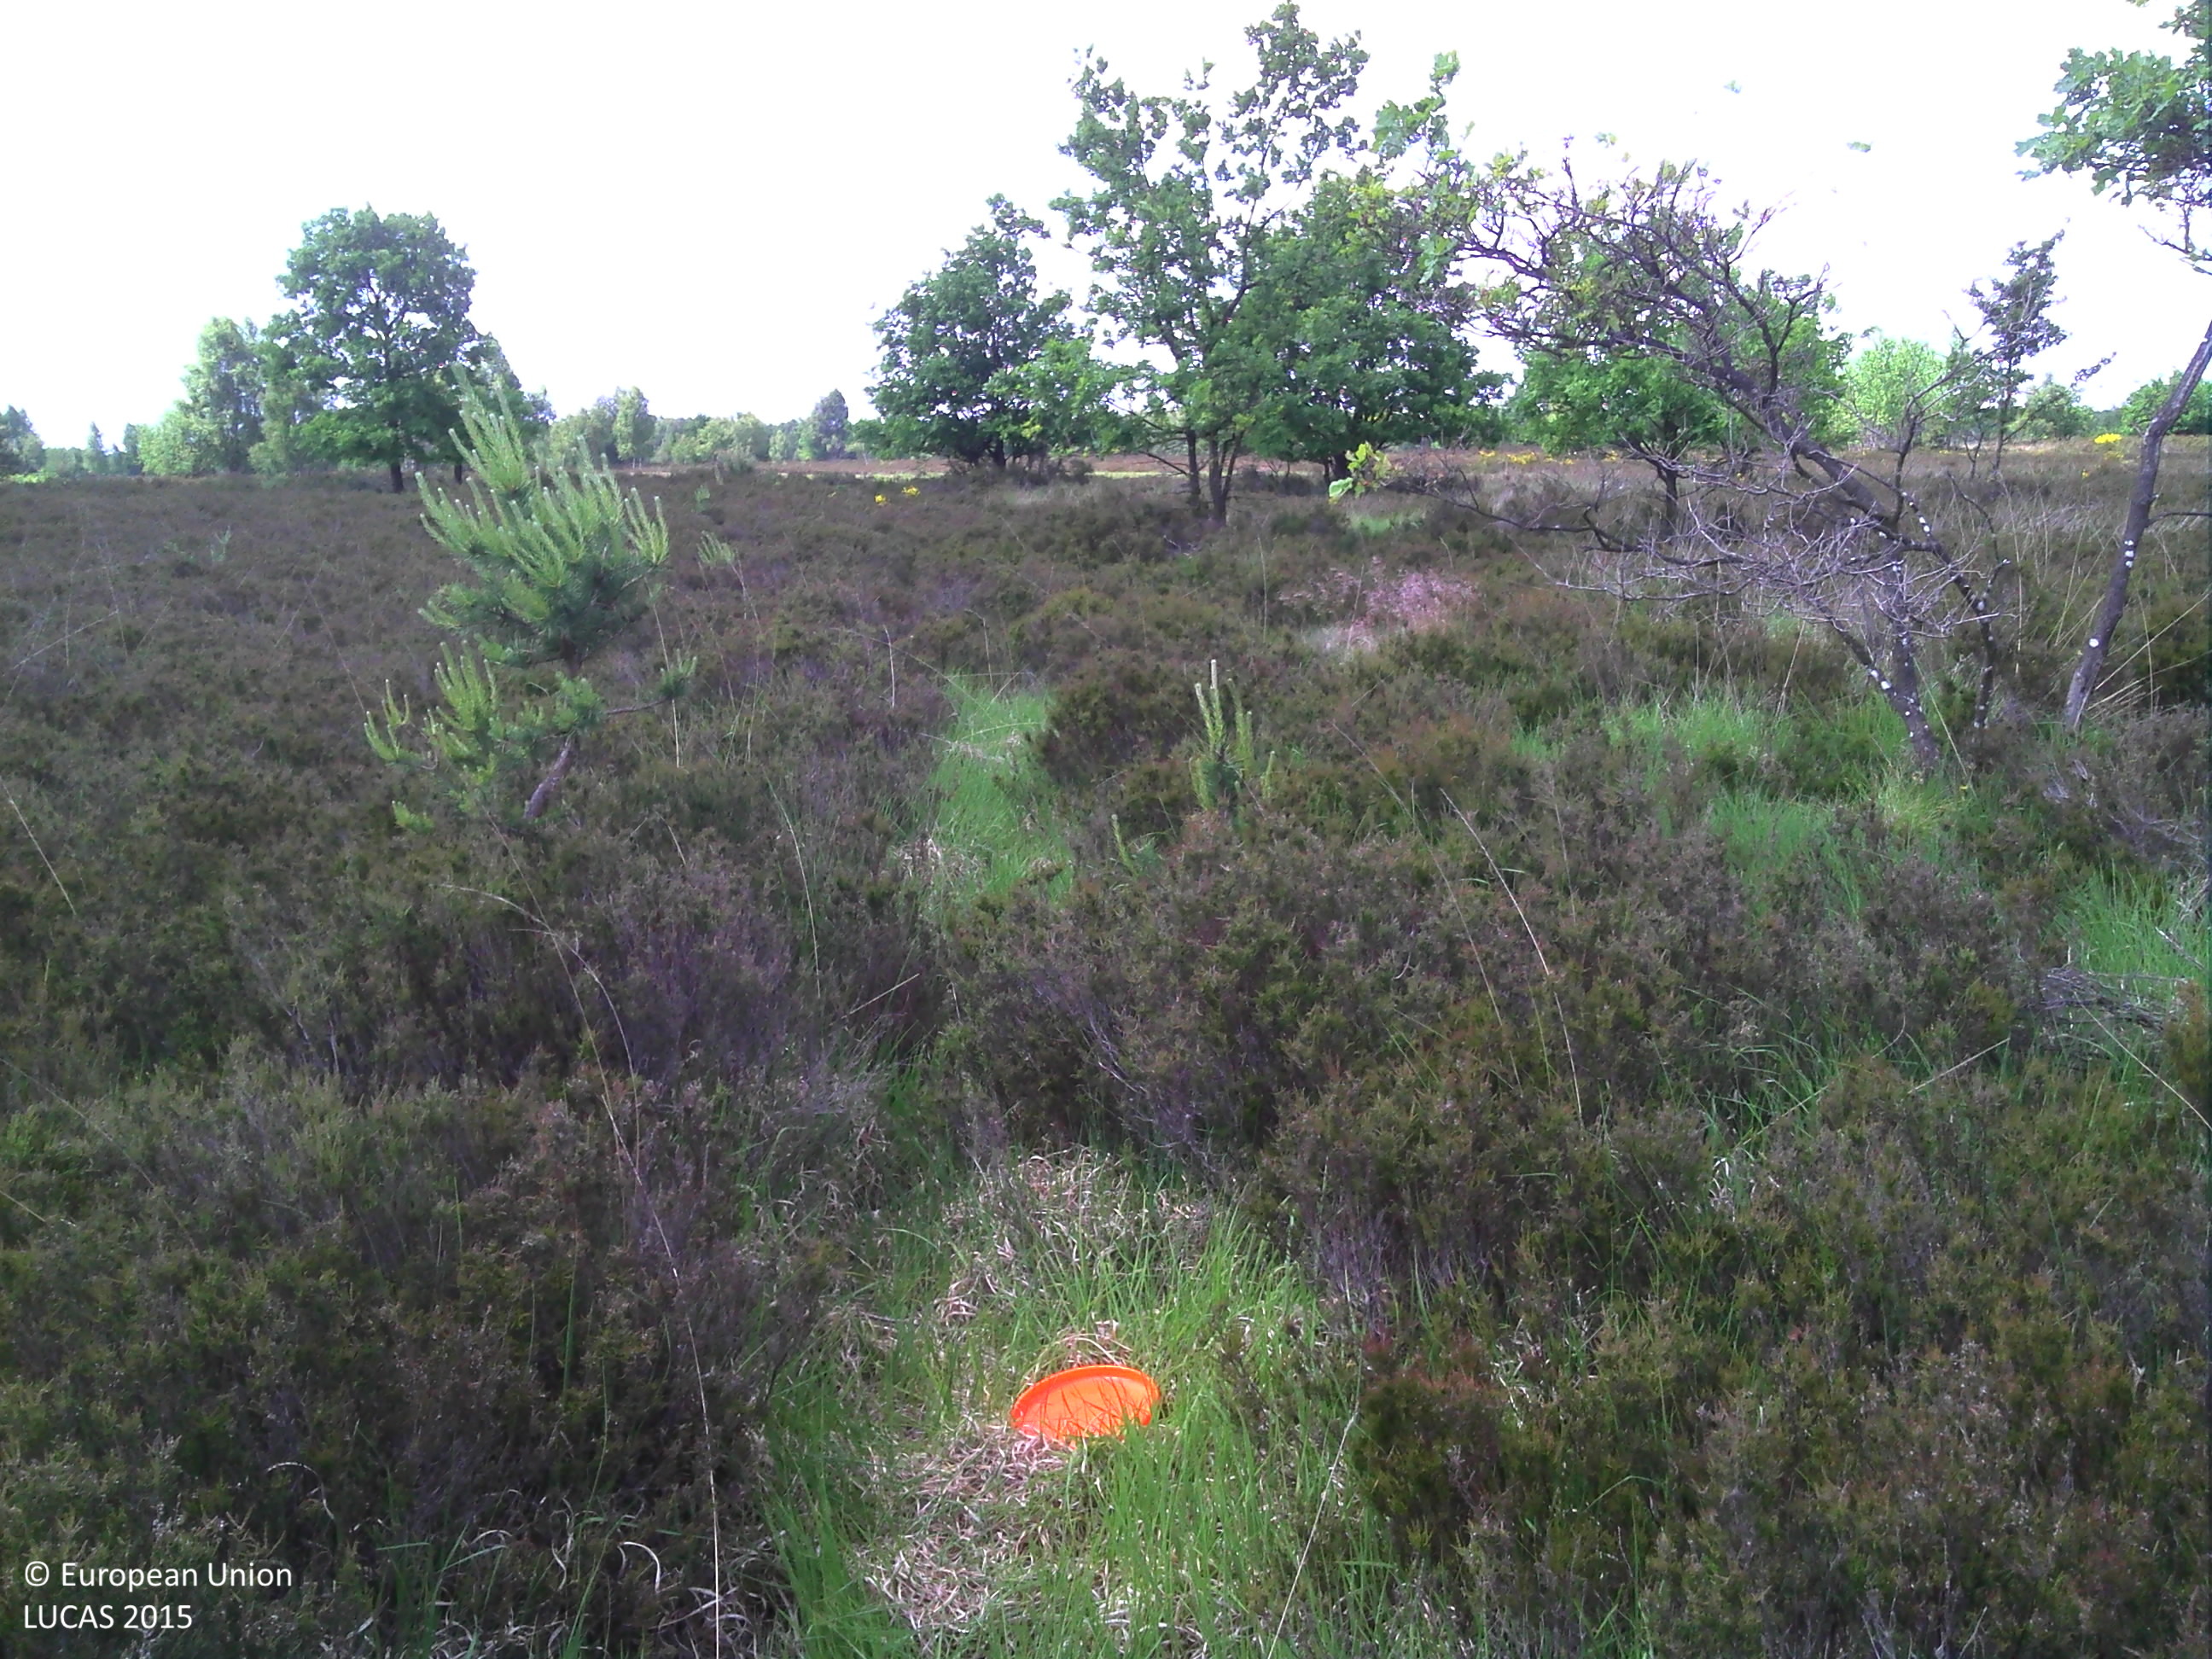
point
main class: Shrubland
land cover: Shrubland with sparse tree cover
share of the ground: > 75 %
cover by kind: shrubs 90 %, broadleaved forest trees 5 %, herbaceous plants 5 %
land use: Semi-natural and natural areas not in use
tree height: < 5 m
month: June
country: BE
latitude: 50.9827
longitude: 5.6253
